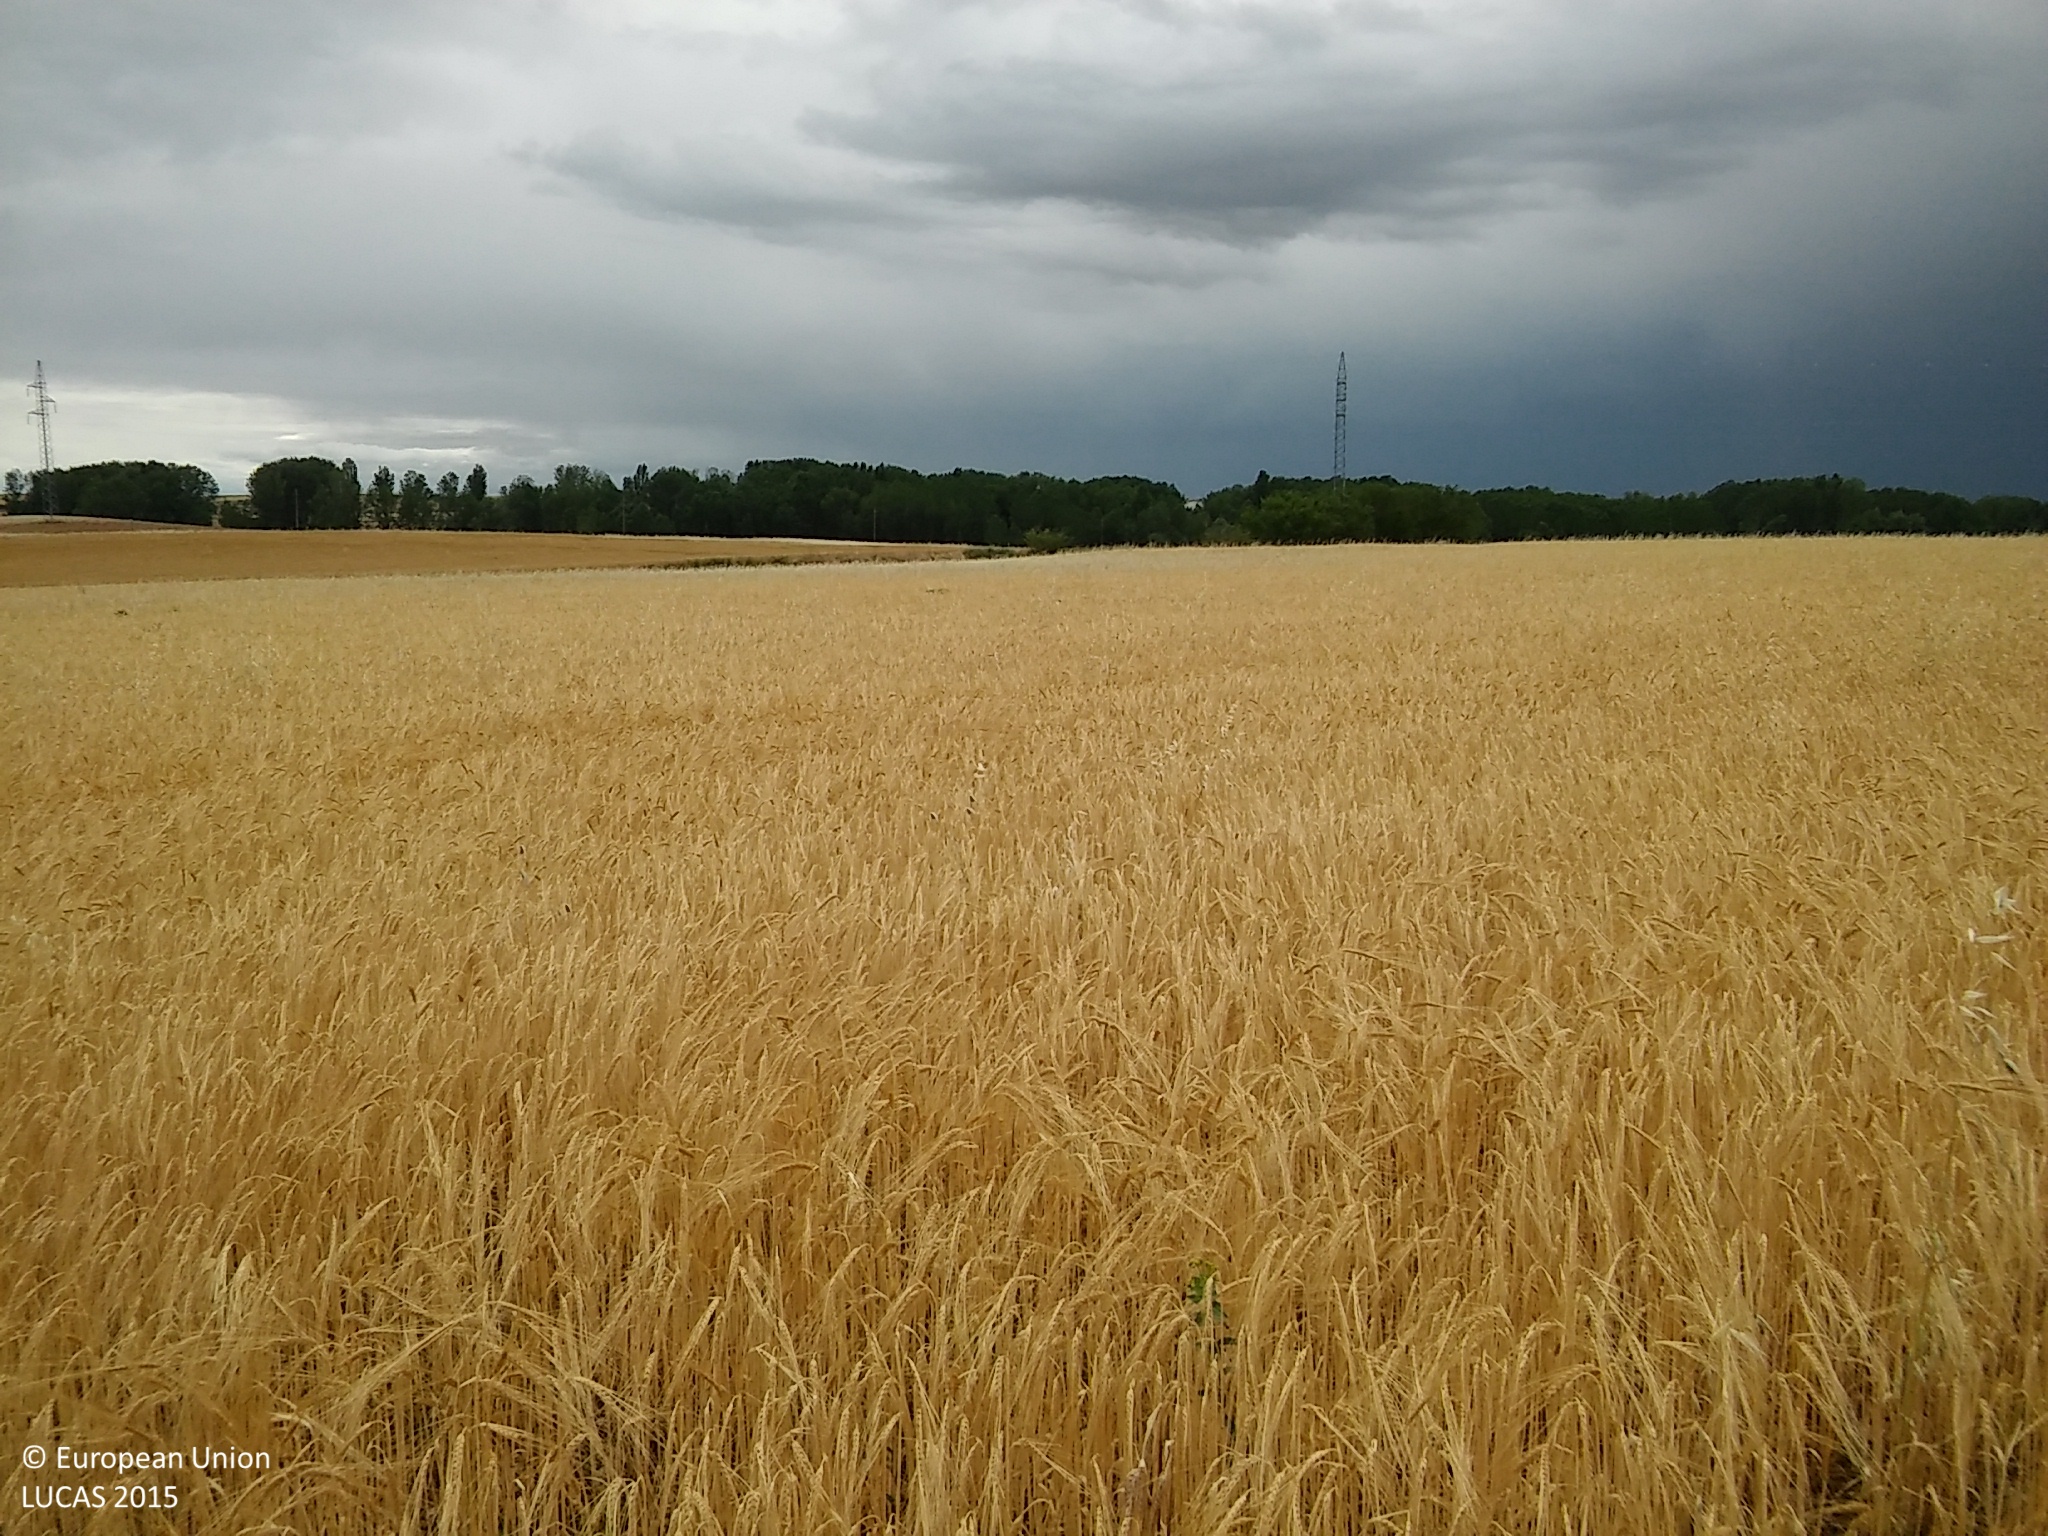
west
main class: Cropland
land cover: Barley
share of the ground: > 75 %
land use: Agriculture (excluding fallow land and kitchen gardens)
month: June
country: ES
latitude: 41.5427
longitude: -3.7781
